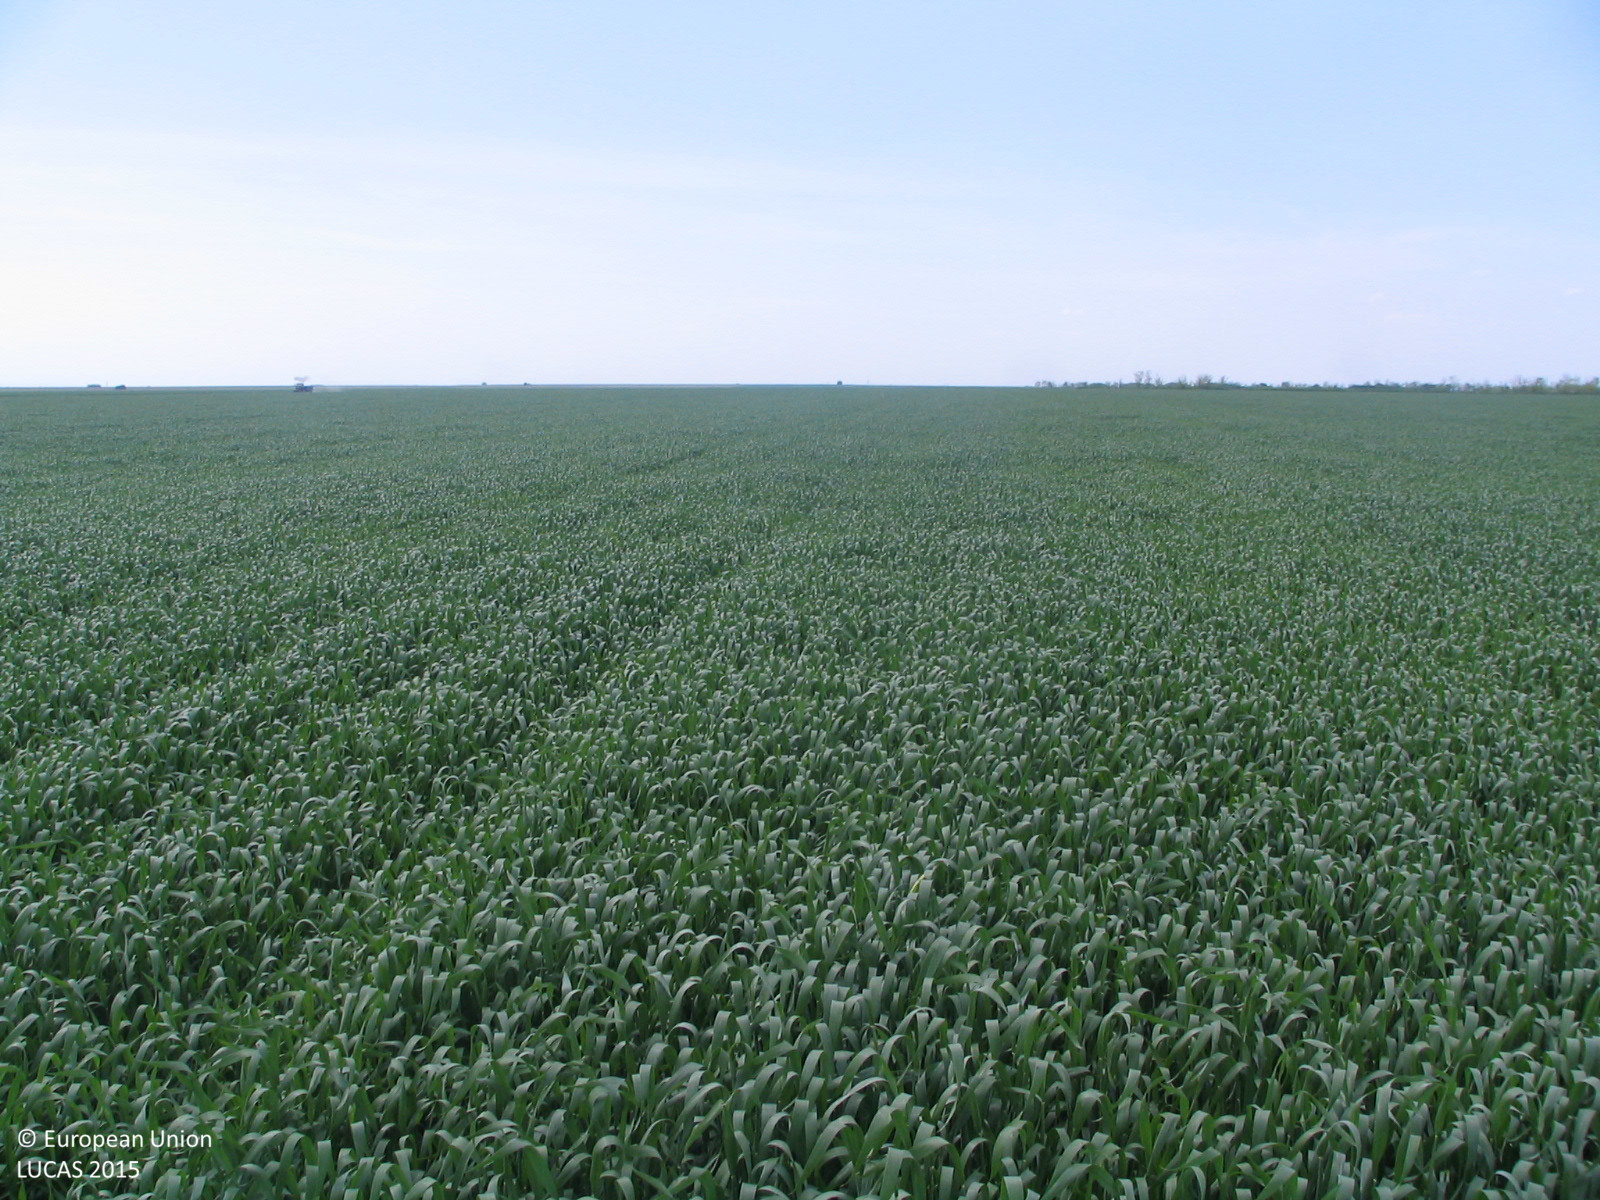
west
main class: Cropland
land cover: Common wheat
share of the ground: > 75 %
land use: Agriculture (excluding fallow land and kitchen gardens)
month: May
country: BG
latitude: 43.5986
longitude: 23.9897
